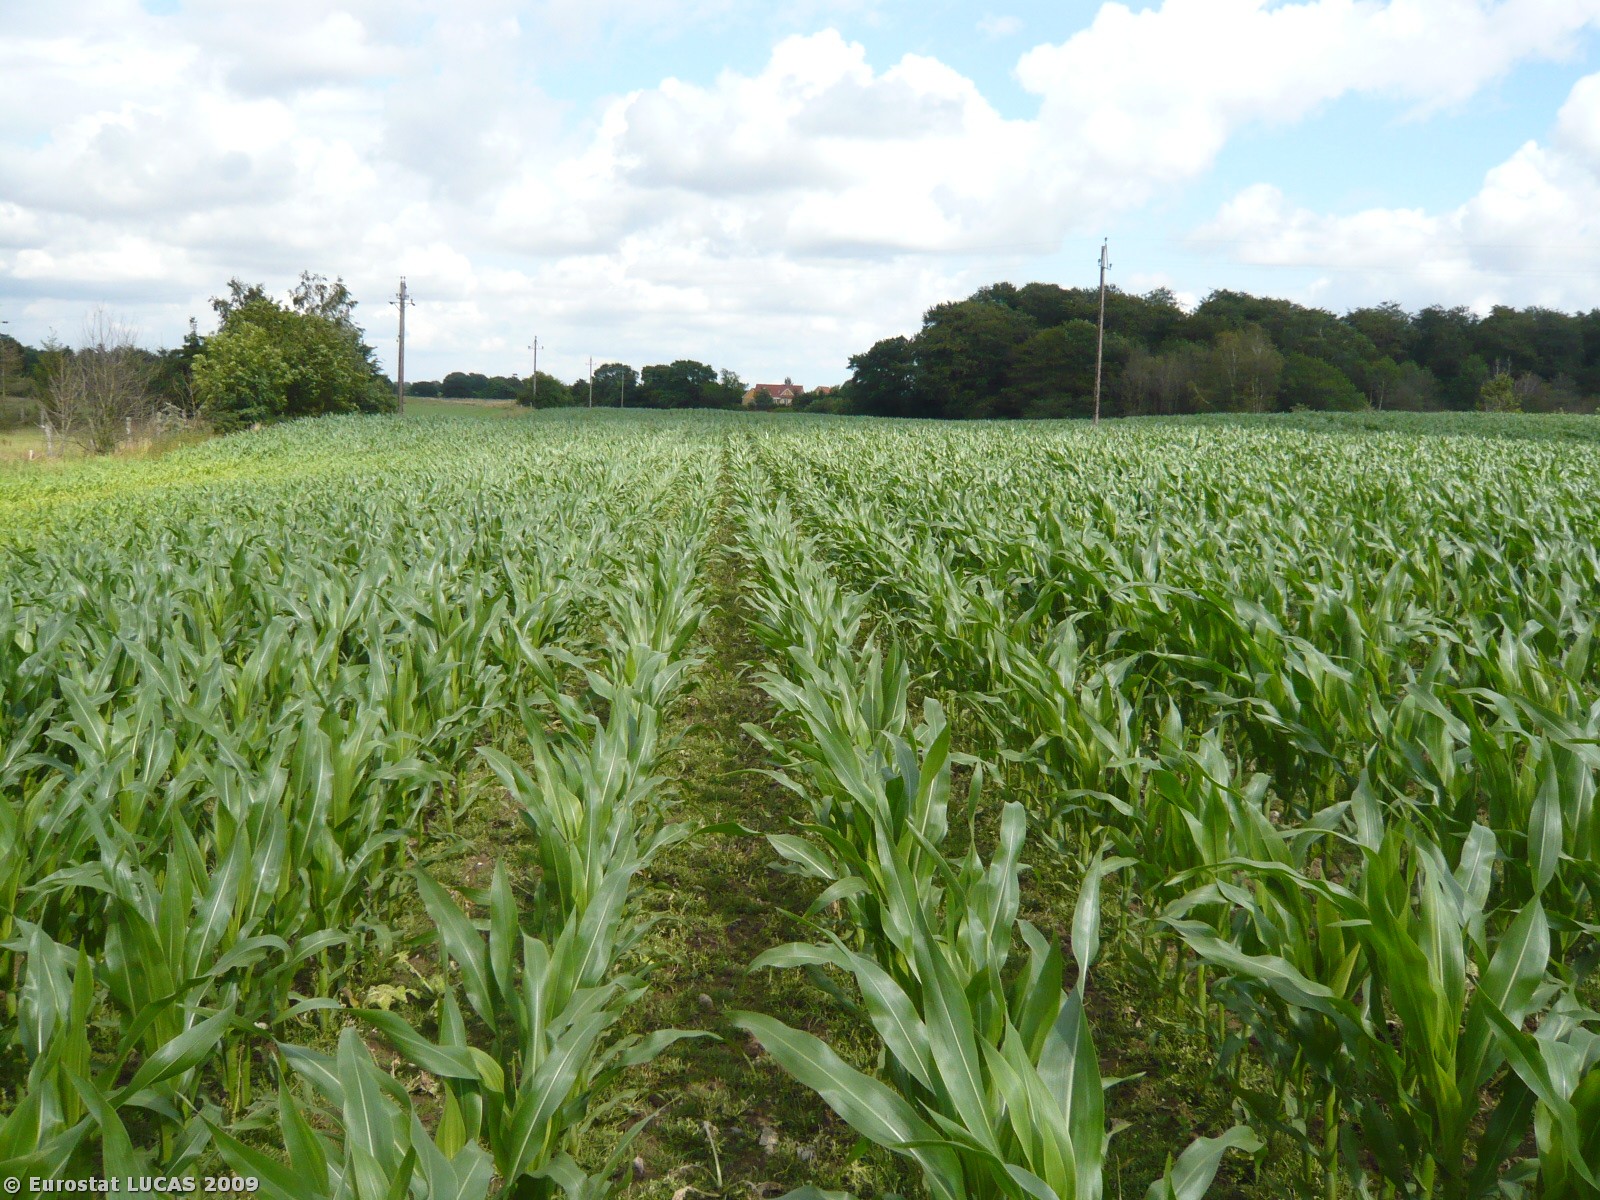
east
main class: Cropland
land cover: Maize
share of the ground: > 75 %
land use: Agriculture (excluding fallow land and kitchen gardens)
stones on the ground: < 10 %
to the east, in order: Maize; Electric lines; Maize; Broadleaved woodland
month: July
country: DK
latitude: 55.5267
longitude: 11.8835
